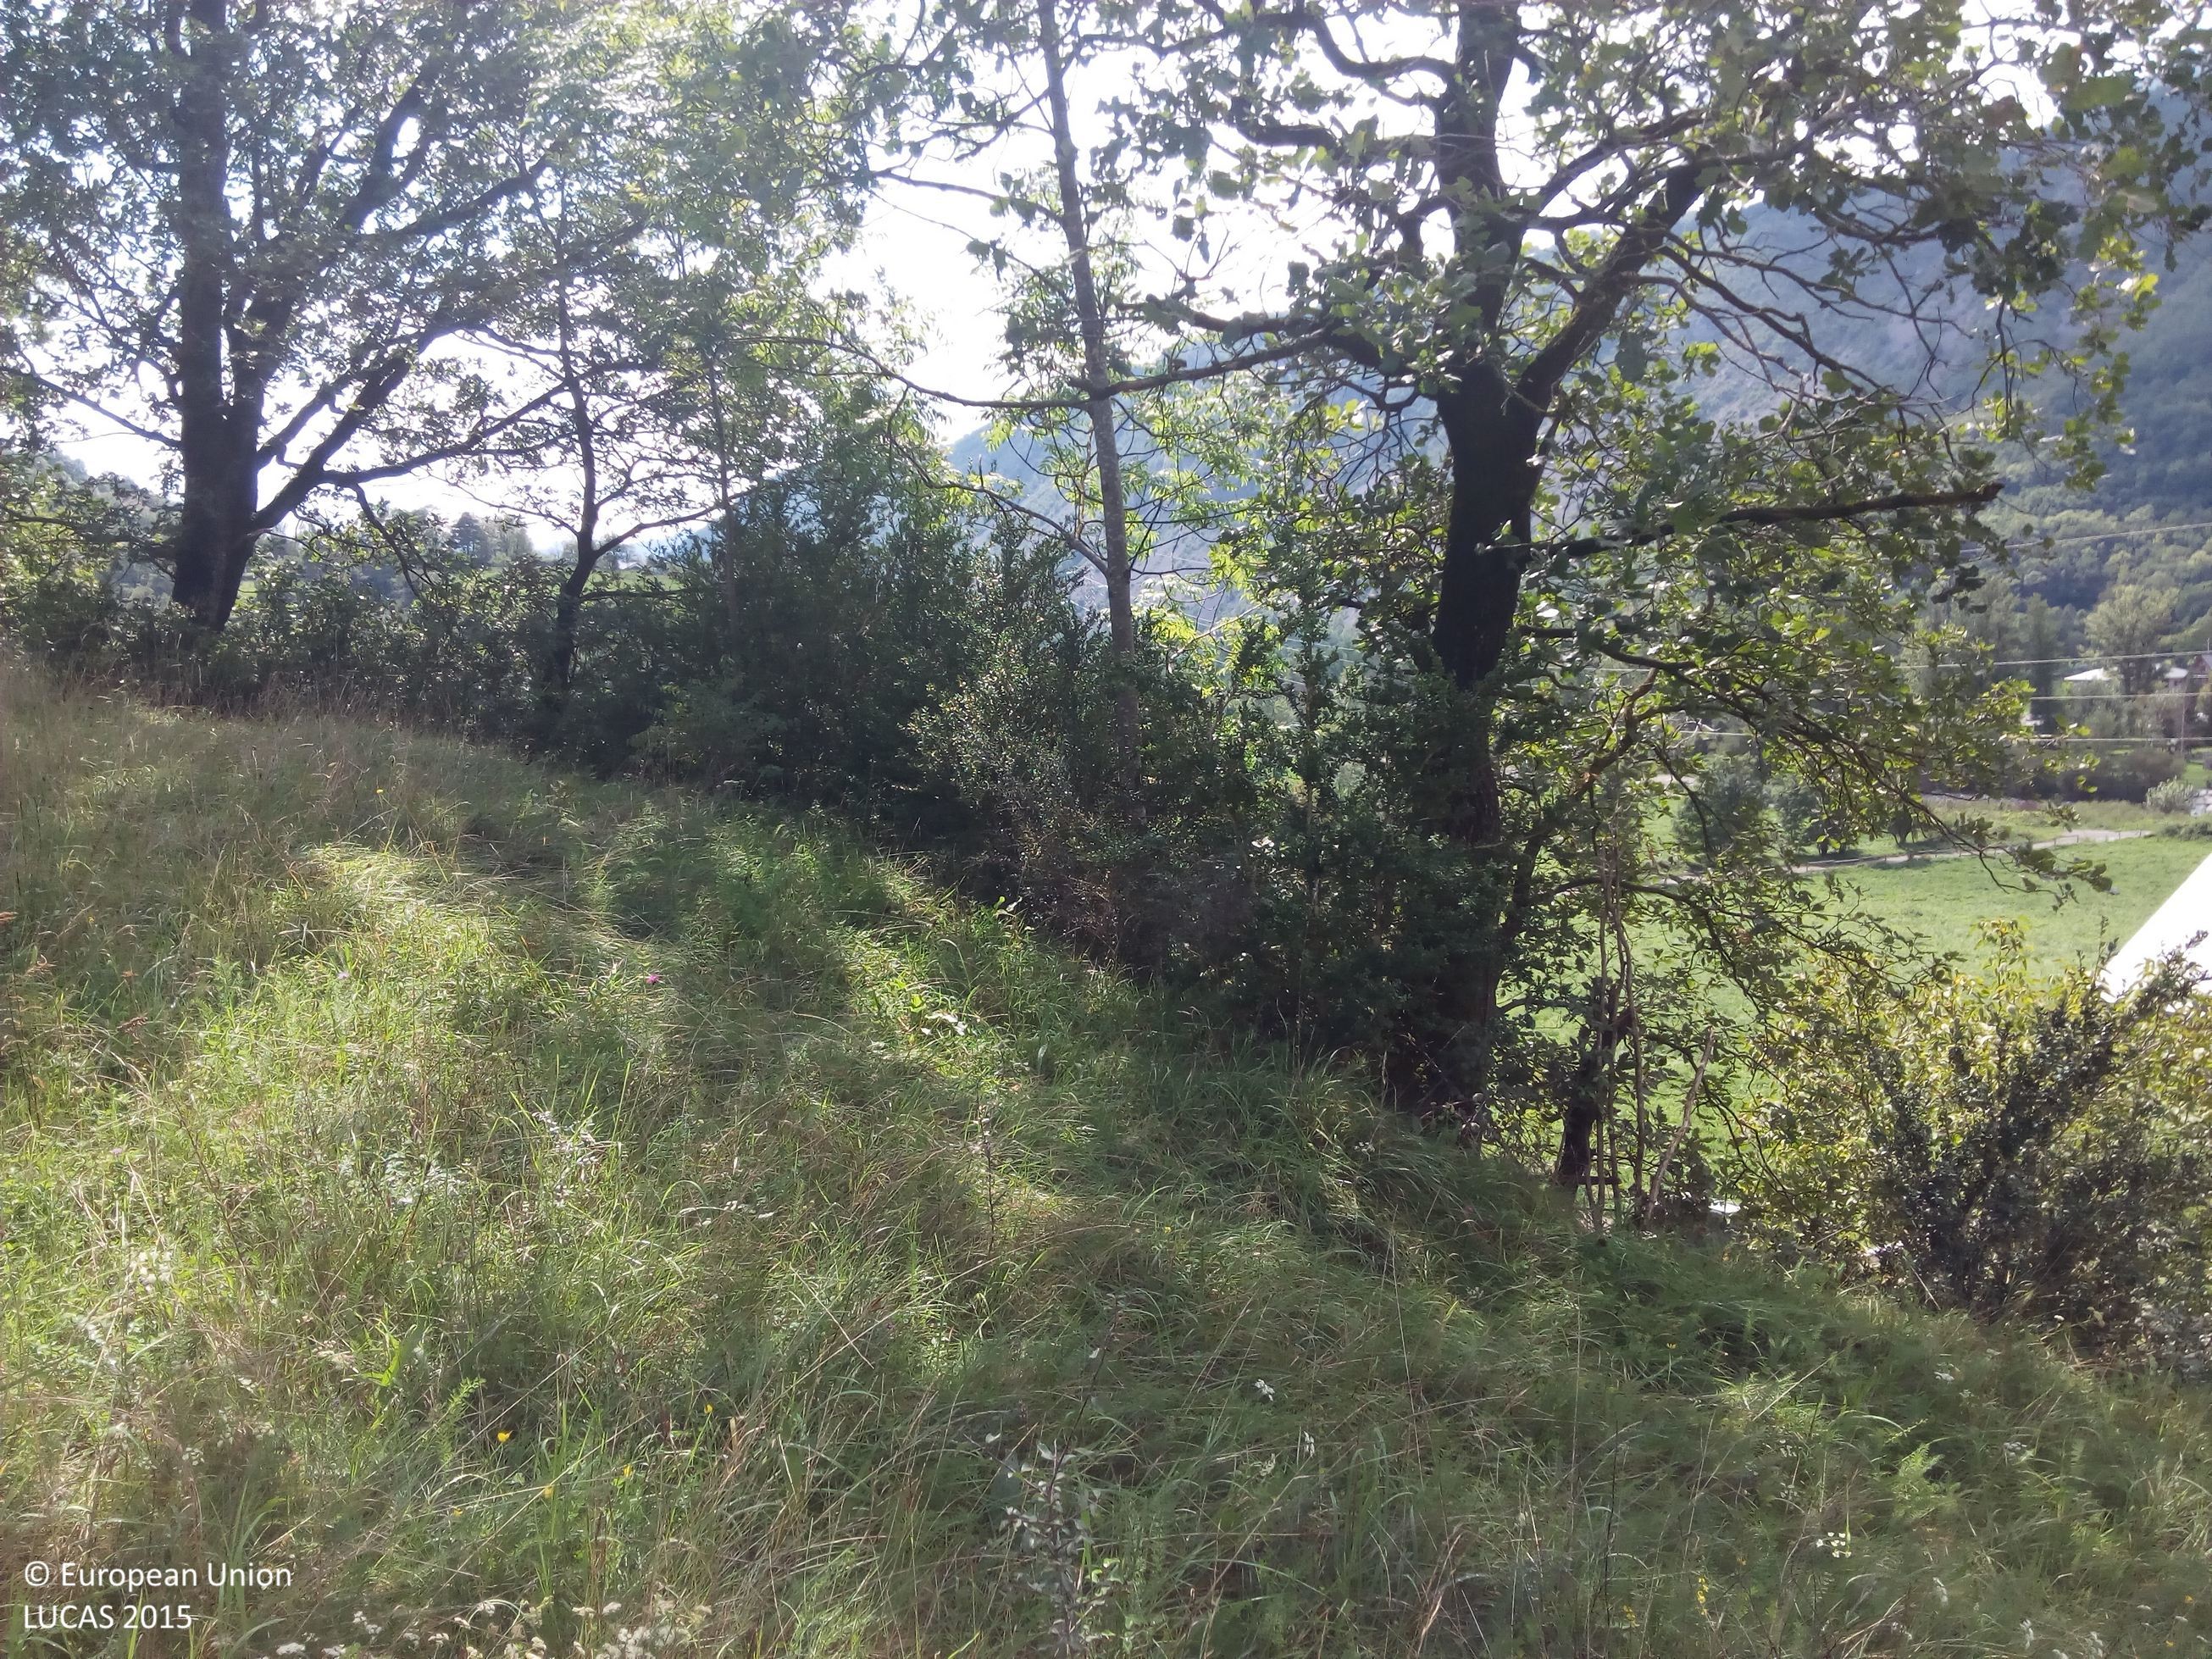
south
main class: Grassland
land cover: Grassland without tree/shrub cover
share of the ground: > 75 %
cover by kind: herbaceous plants 100 %
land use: Agriculture (excluding fallow land and kitchen gardens)
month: September
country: ES
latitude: 42.5489
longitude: 0.4688
